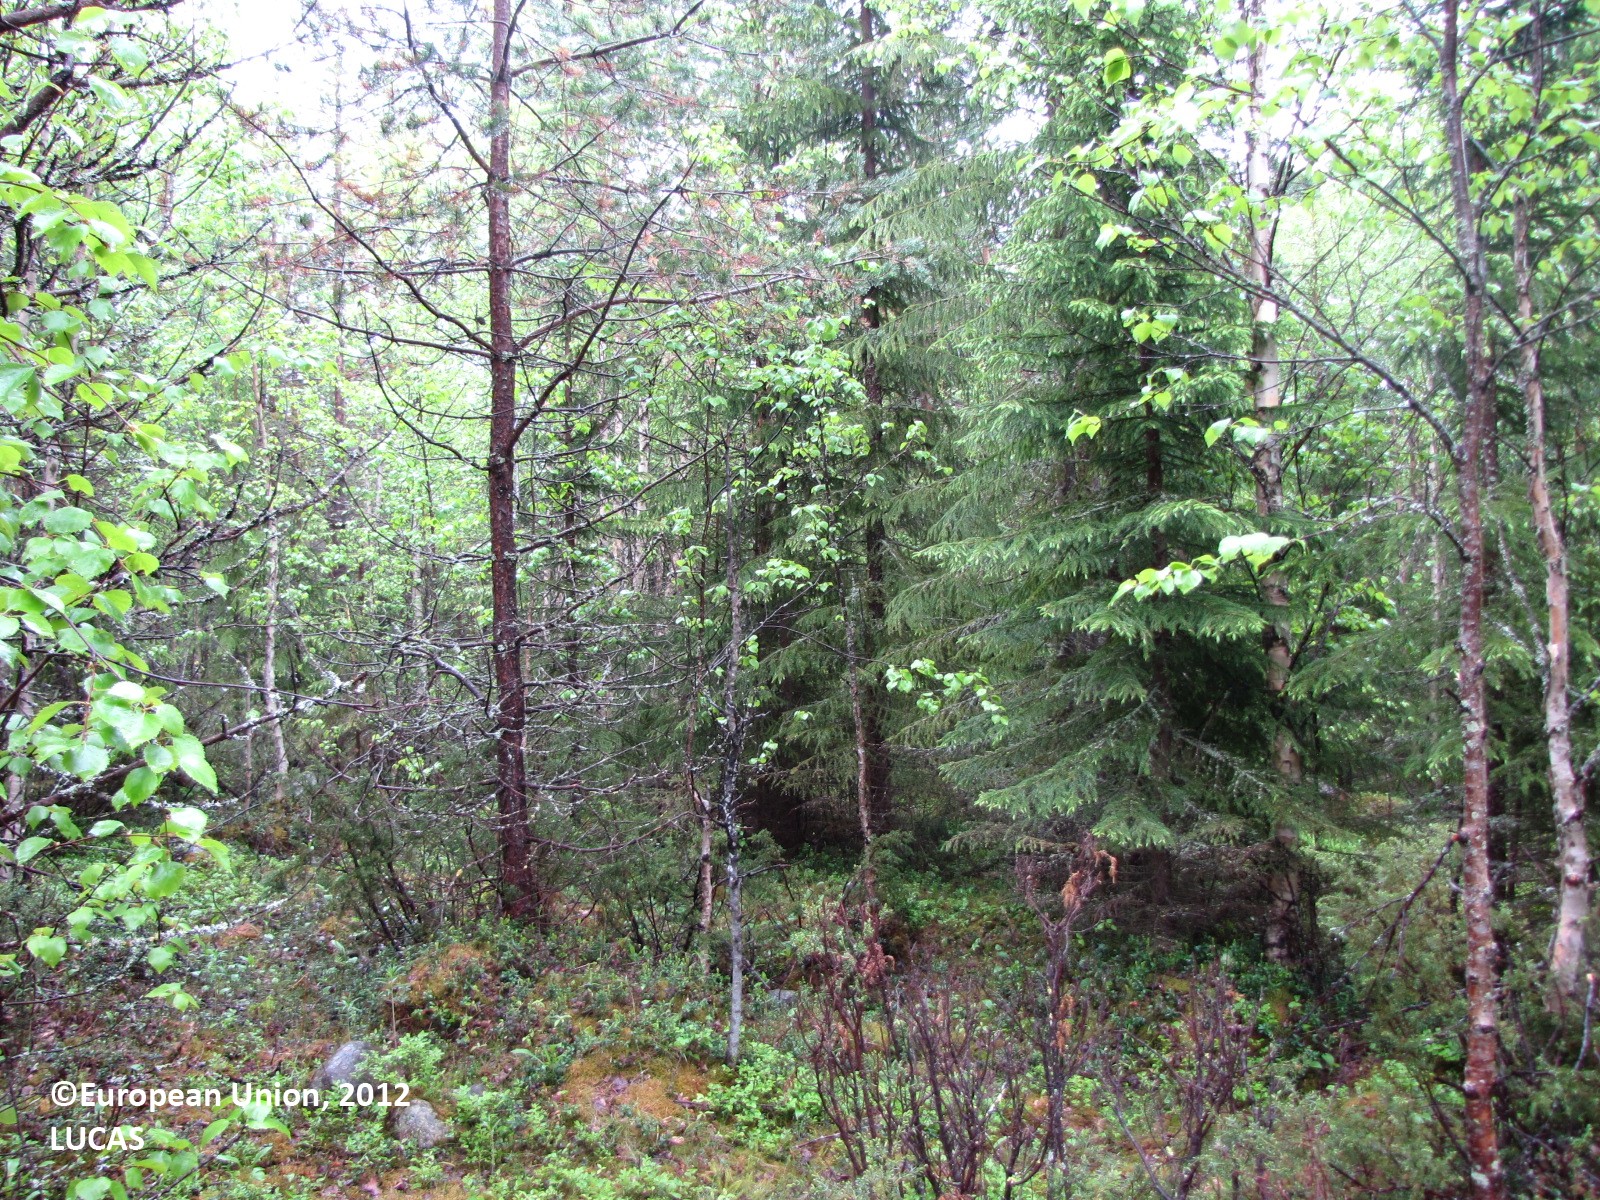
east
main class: Woodland
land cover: Other mixed woodland
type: boreal forest
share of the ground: 50 - 75 %
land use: Forestry
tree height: > 5 m
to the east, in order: Other mixed woodland; Ditches and canals; Other mixed woodland
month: June
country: FI
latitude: 66.0521
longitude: 24.2873
